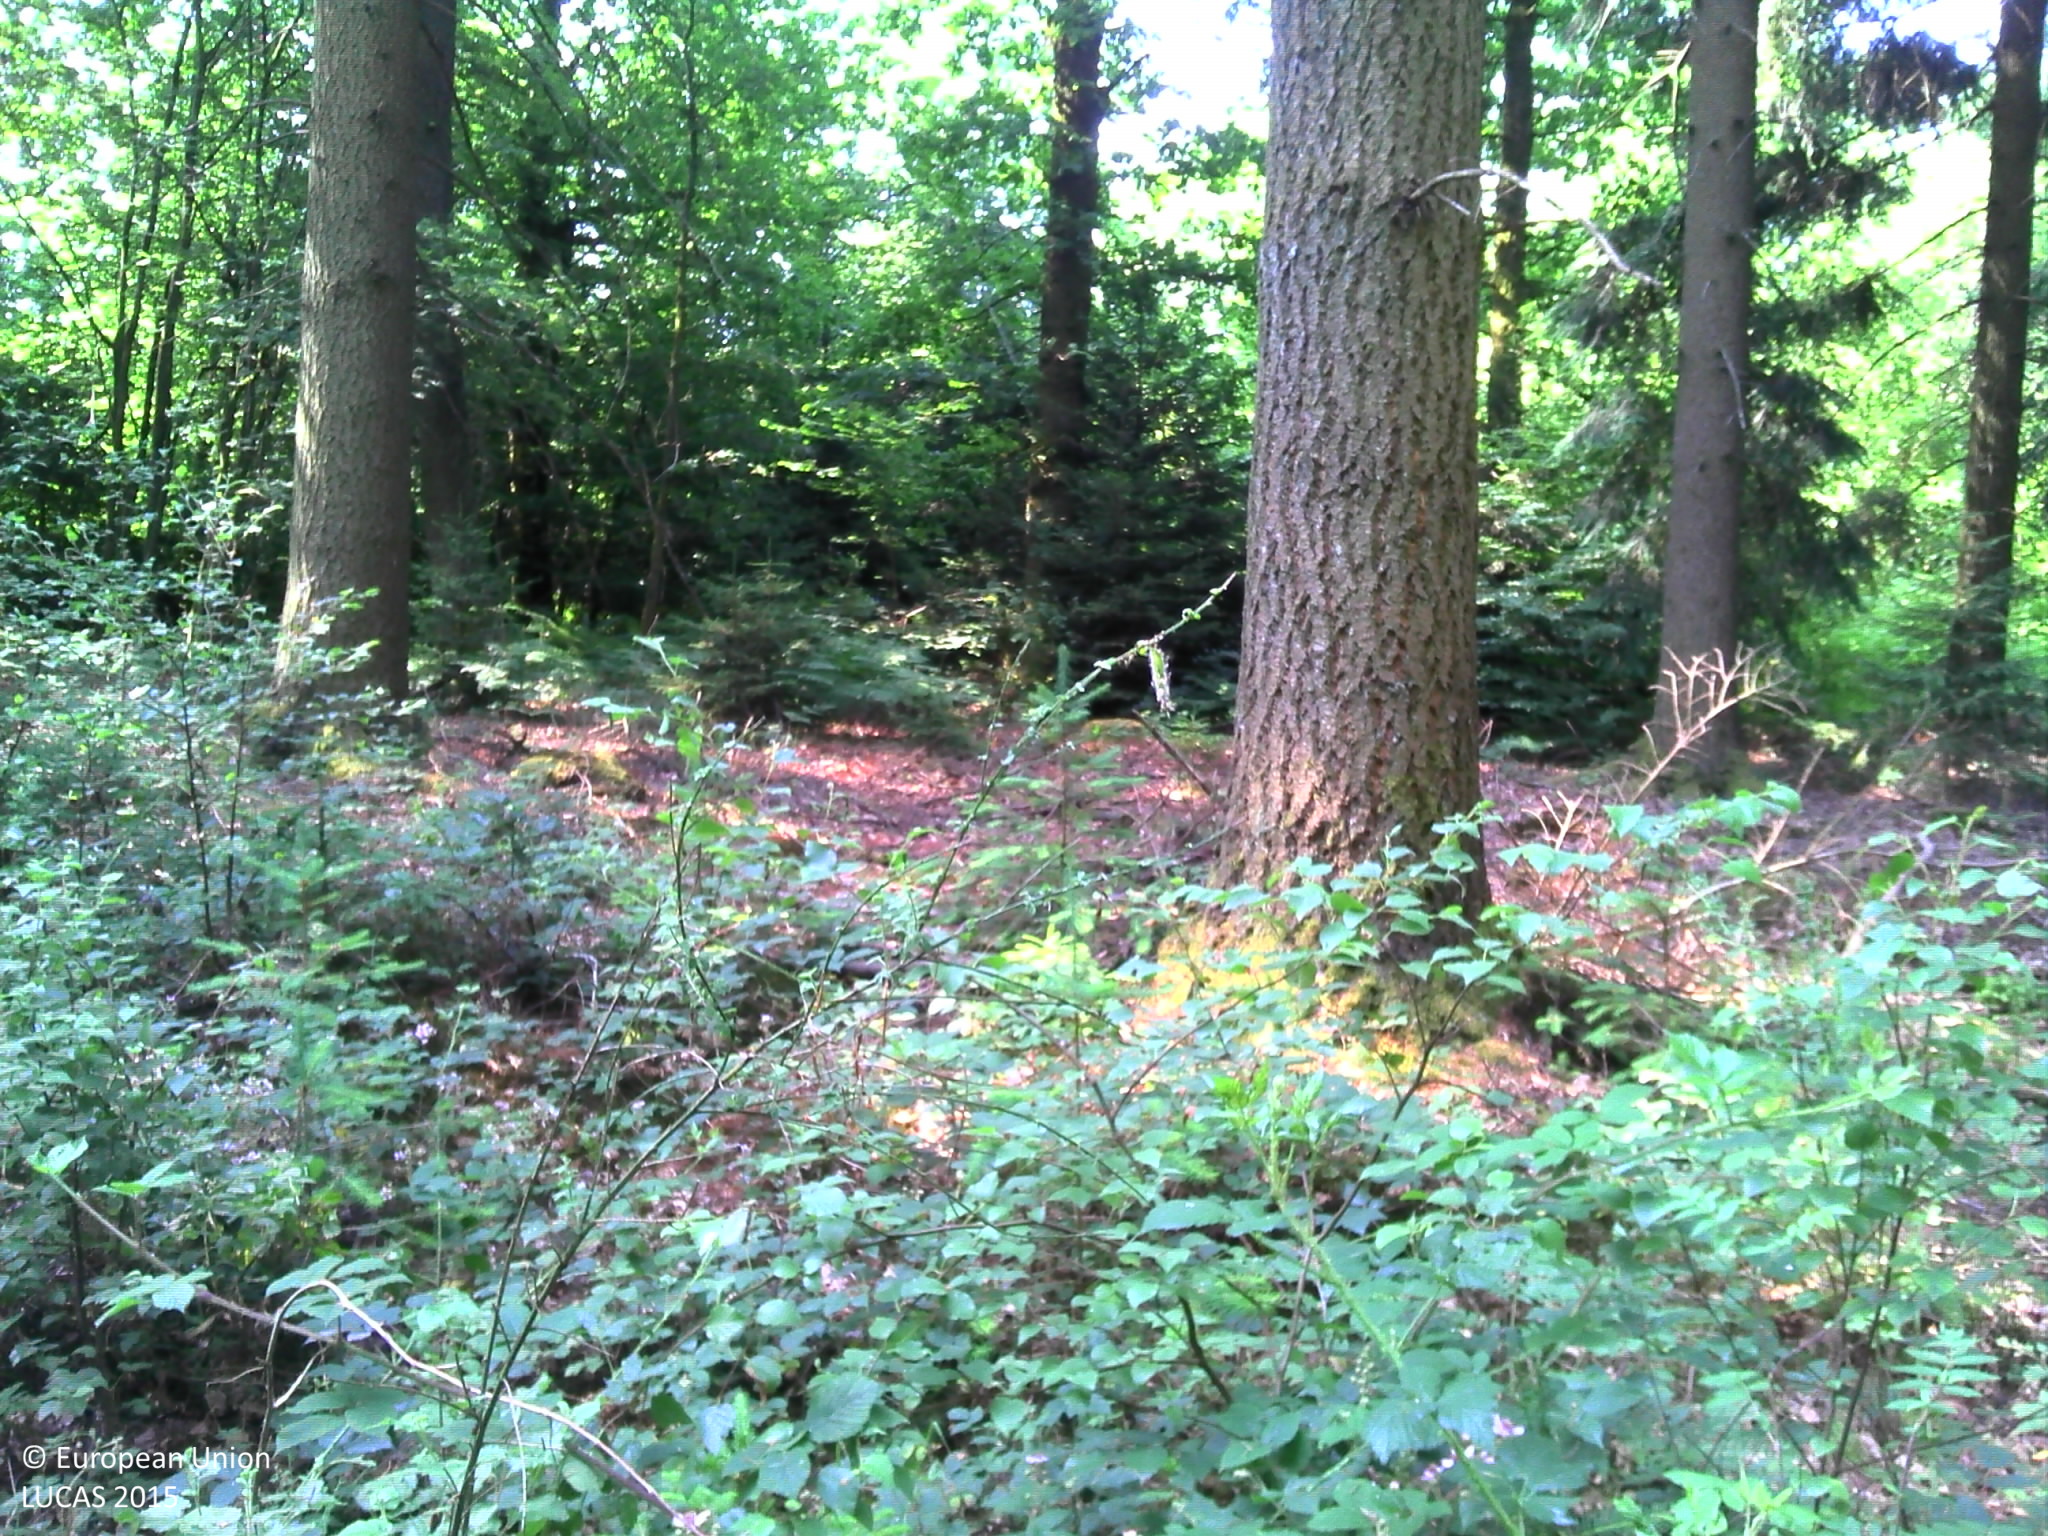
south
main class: Woodland
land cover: Other mixed woodland
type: acidophilous oak and oak-birch forest
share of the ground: > 75 %
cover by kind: coniferous forest trees 65 %, broadleaved forest trees 30 %, herbaceous plants 5 %
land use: Forestry
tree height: > 5 m
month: June
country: BE
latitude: 49.9445
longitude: 4.9108
